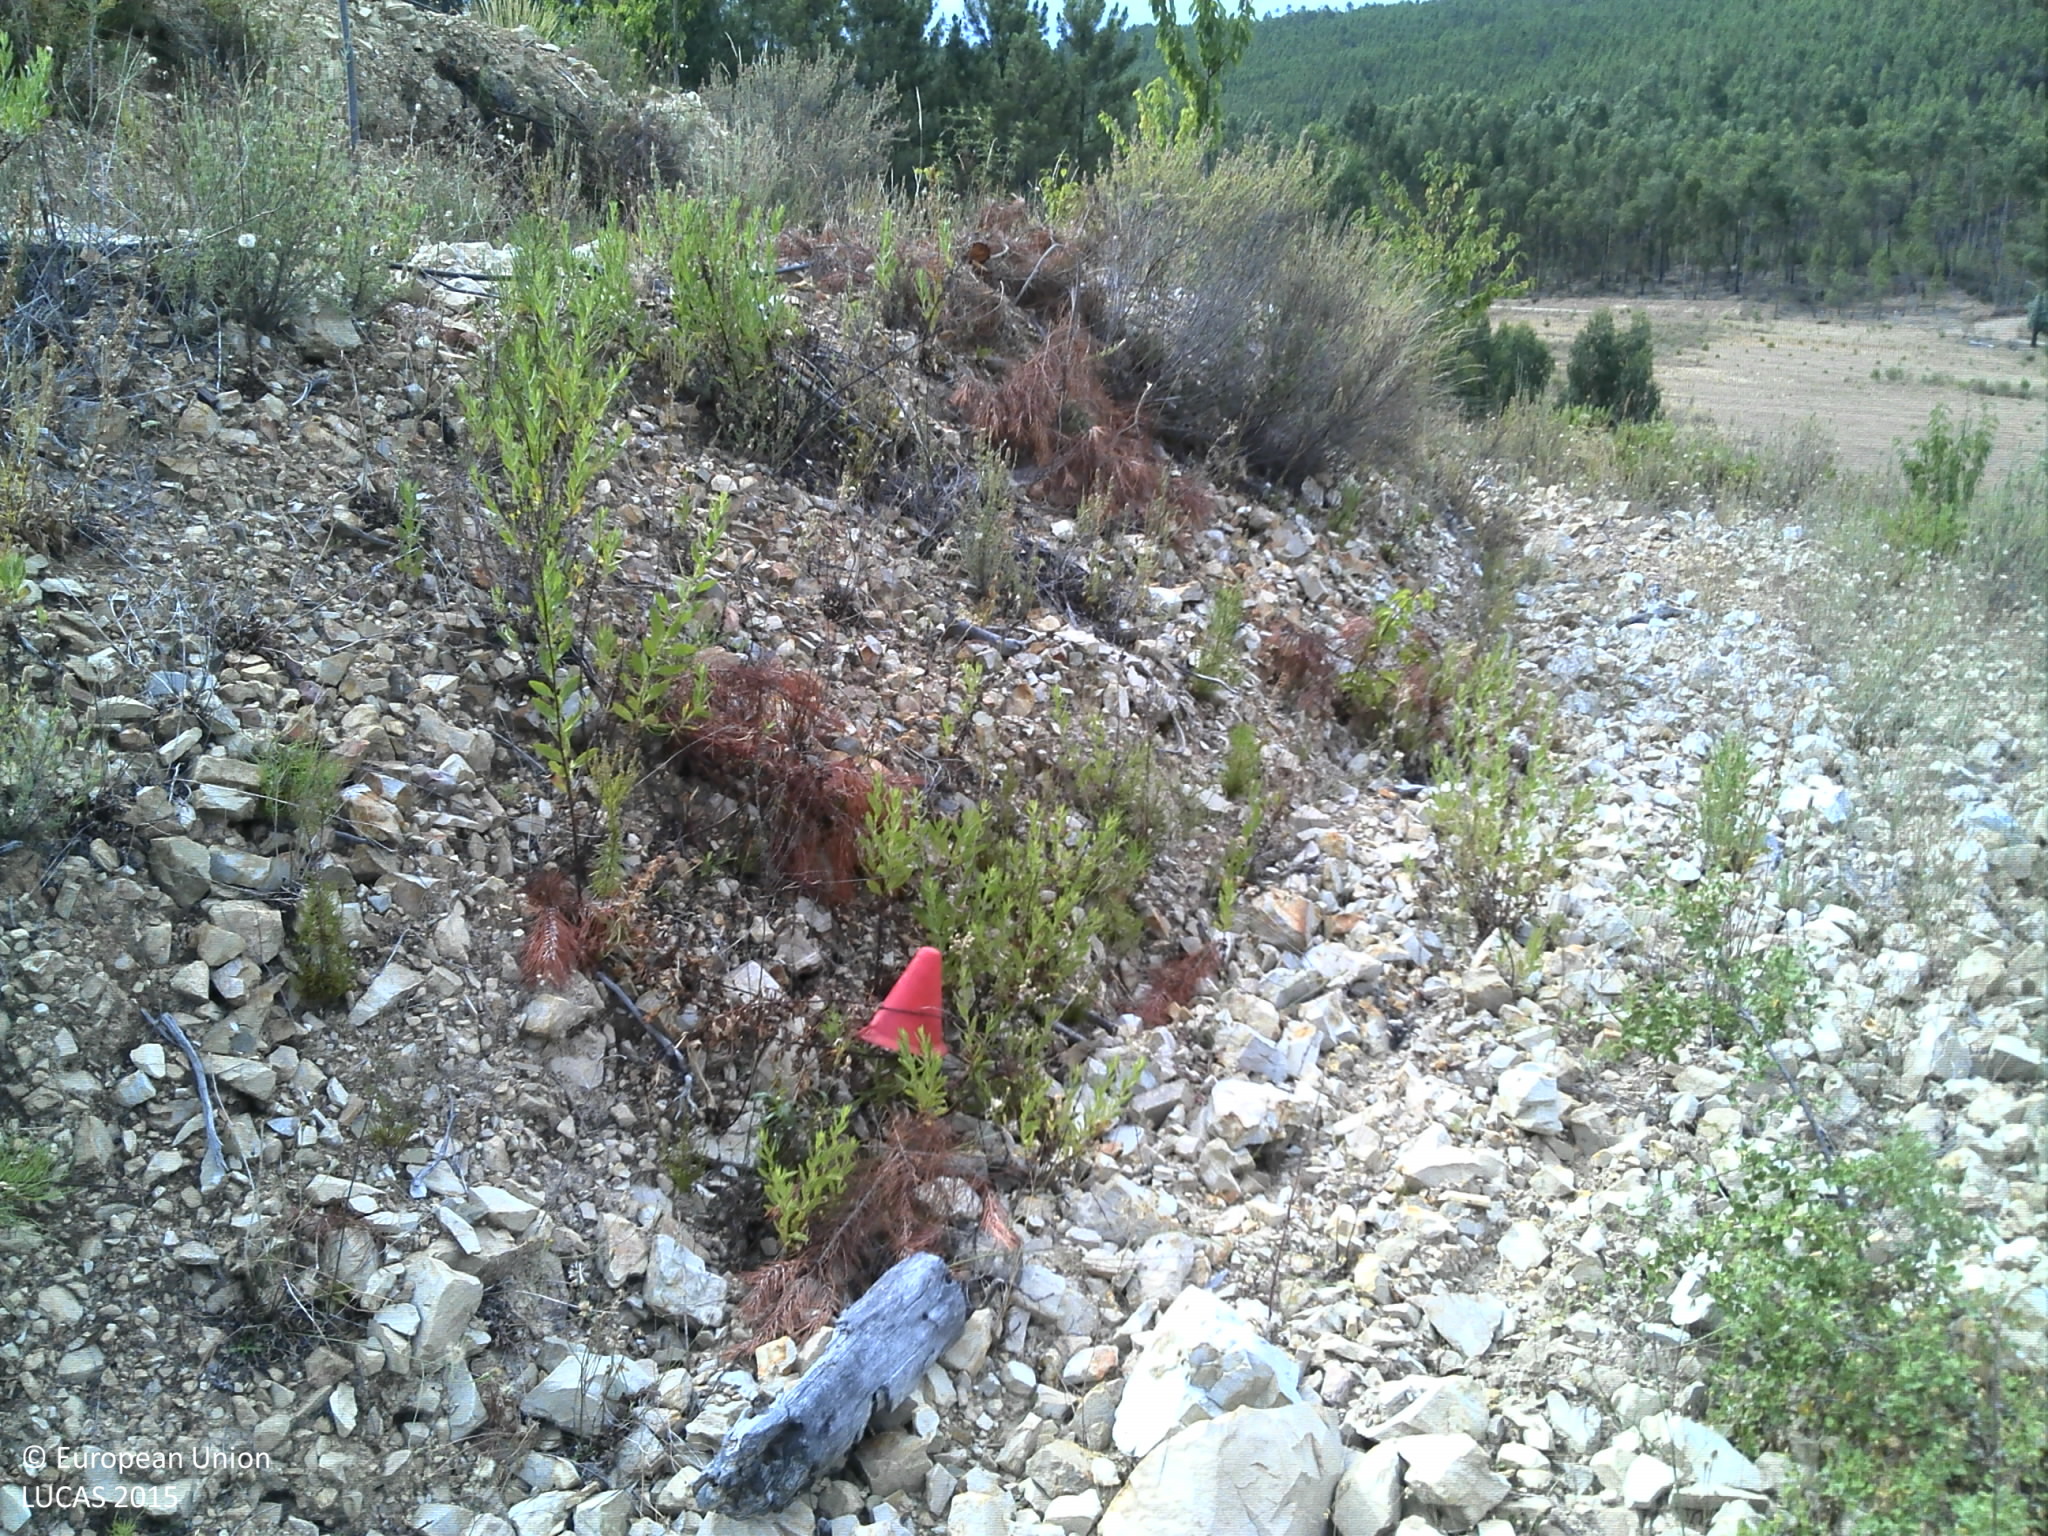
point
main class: Cropland
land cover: Cherry fruit
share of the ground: < 10 %
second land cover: Shrubland without tree cover
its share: 10 - 25 %
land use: Agriculture (excluding fallow land and kitchen gardens)
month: July
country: PT
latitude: 39.6456
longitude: -7.9723
